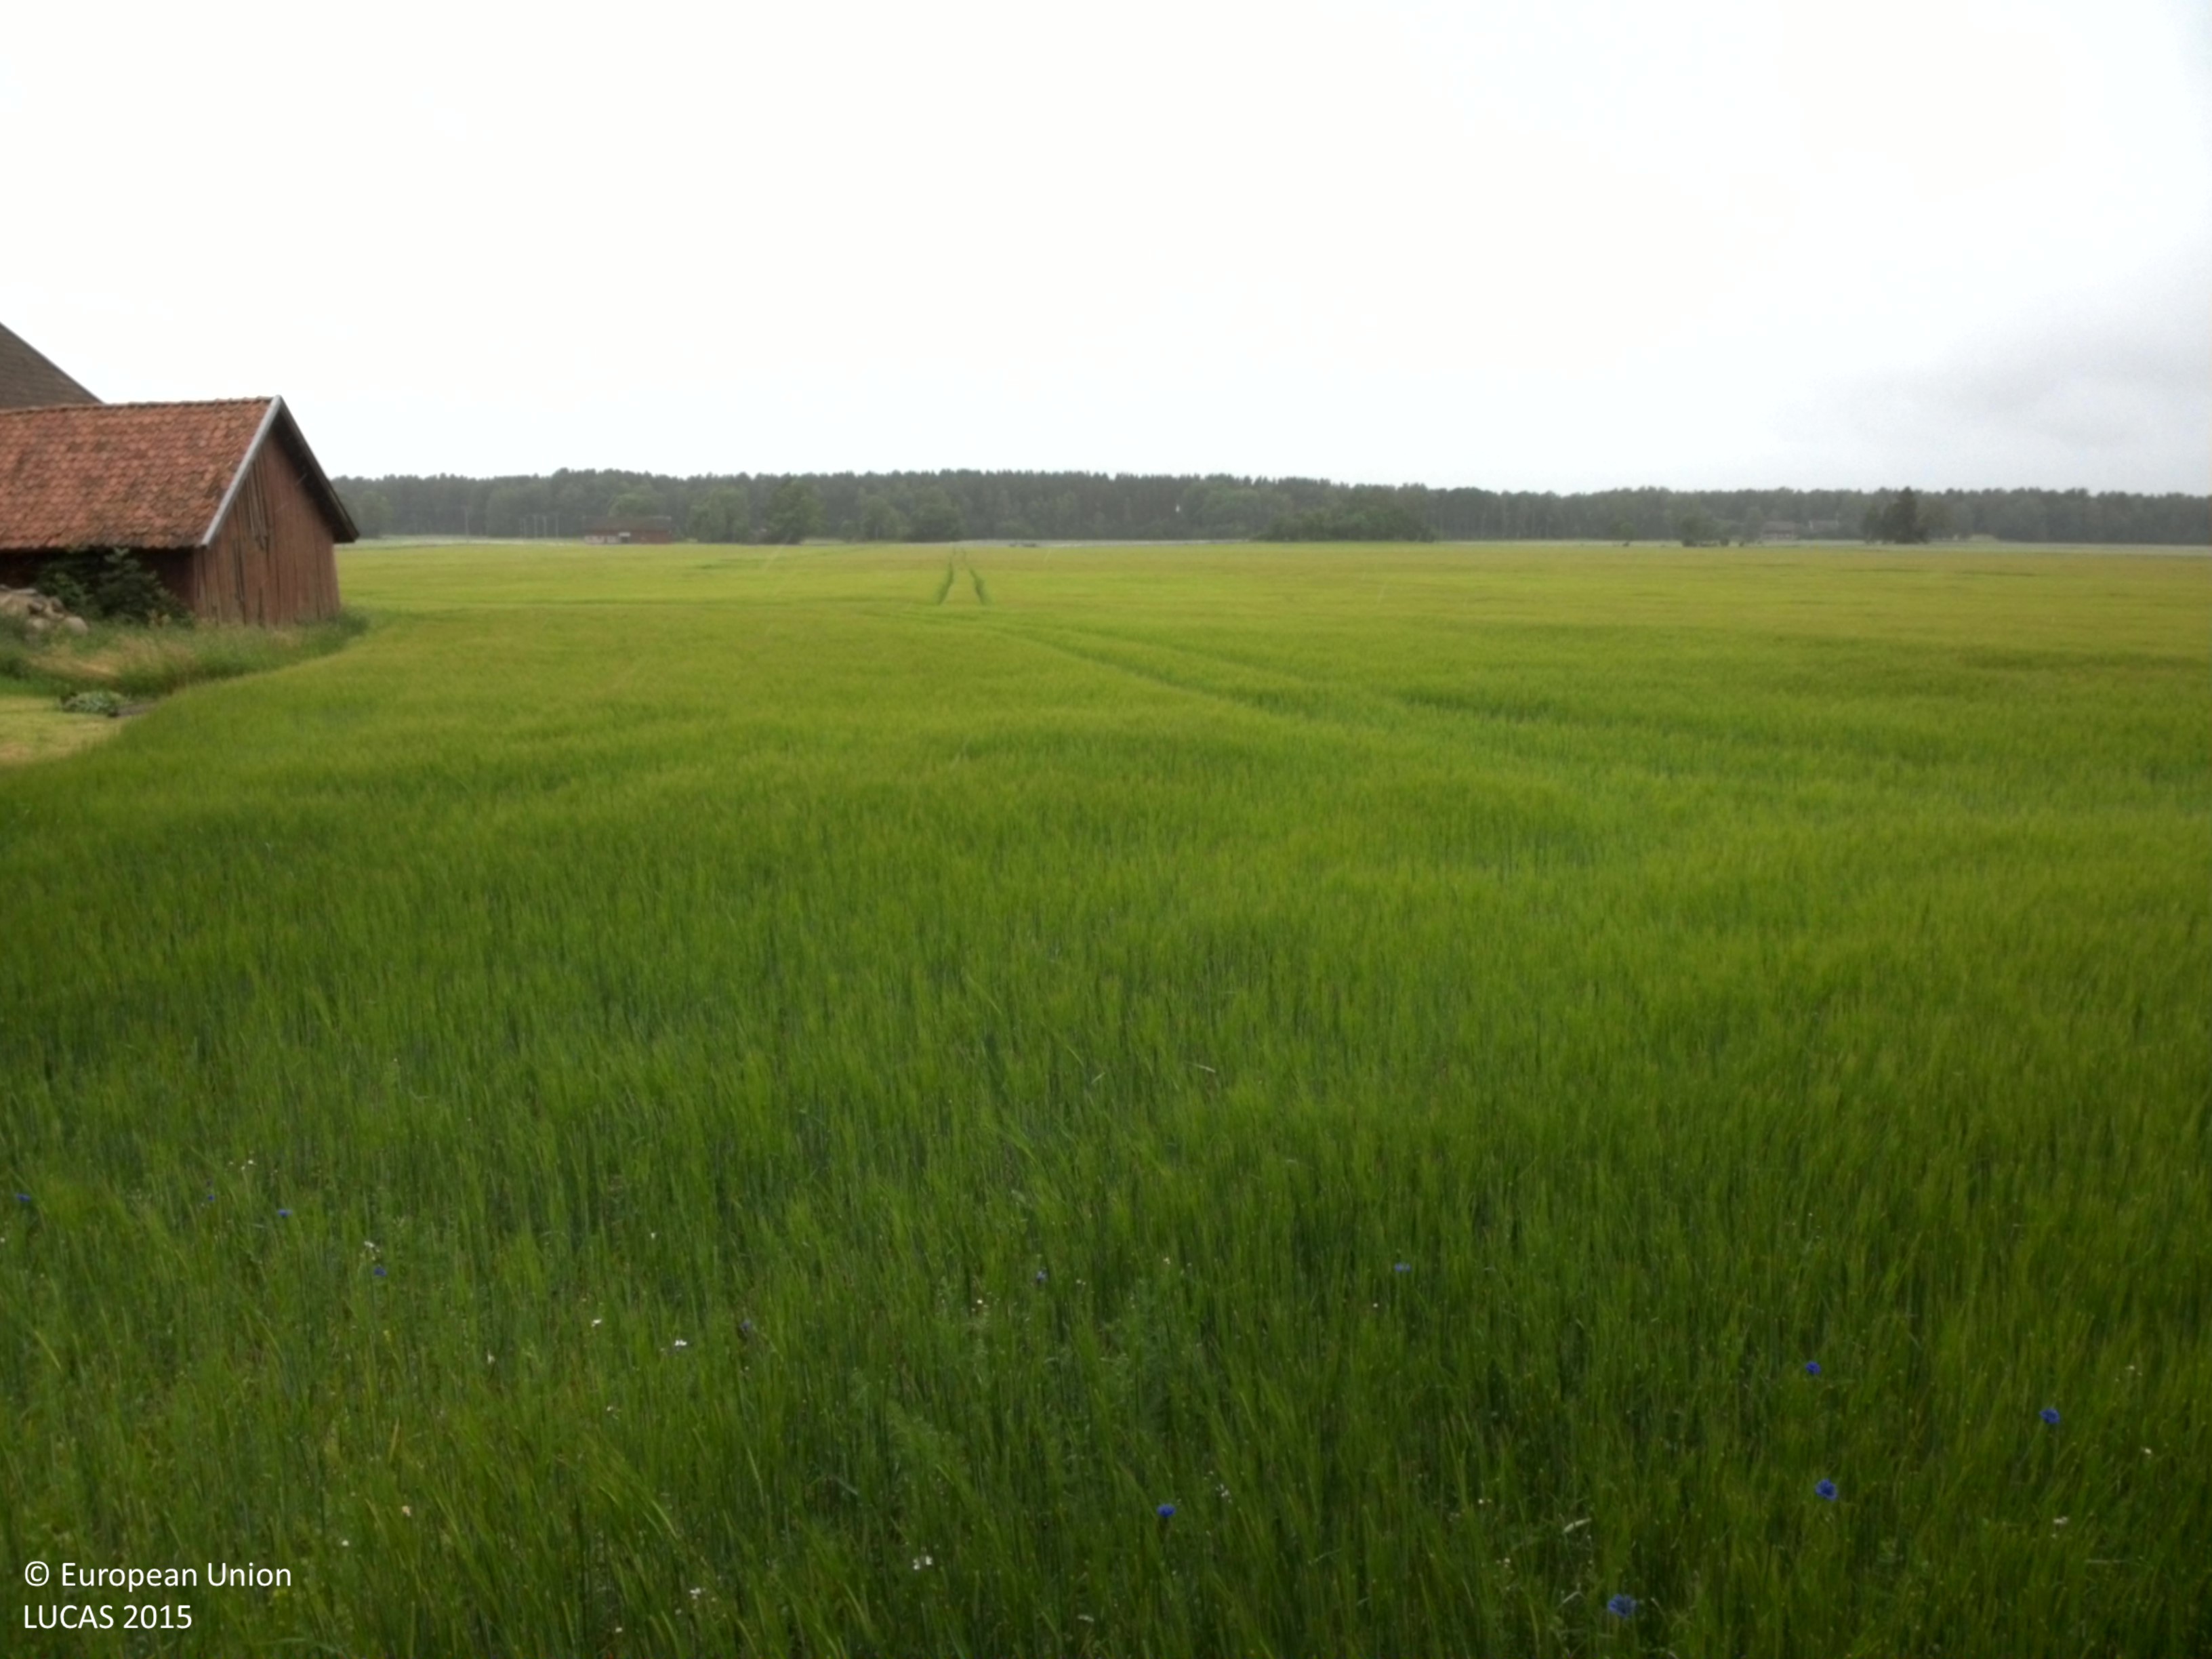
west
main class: Cropland
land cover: Barley
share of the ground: > 75 %
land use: Agriculture (excluding fallow land and kitchen gardens)
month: July
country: SE
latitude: 58.5045
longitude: 13.9235
